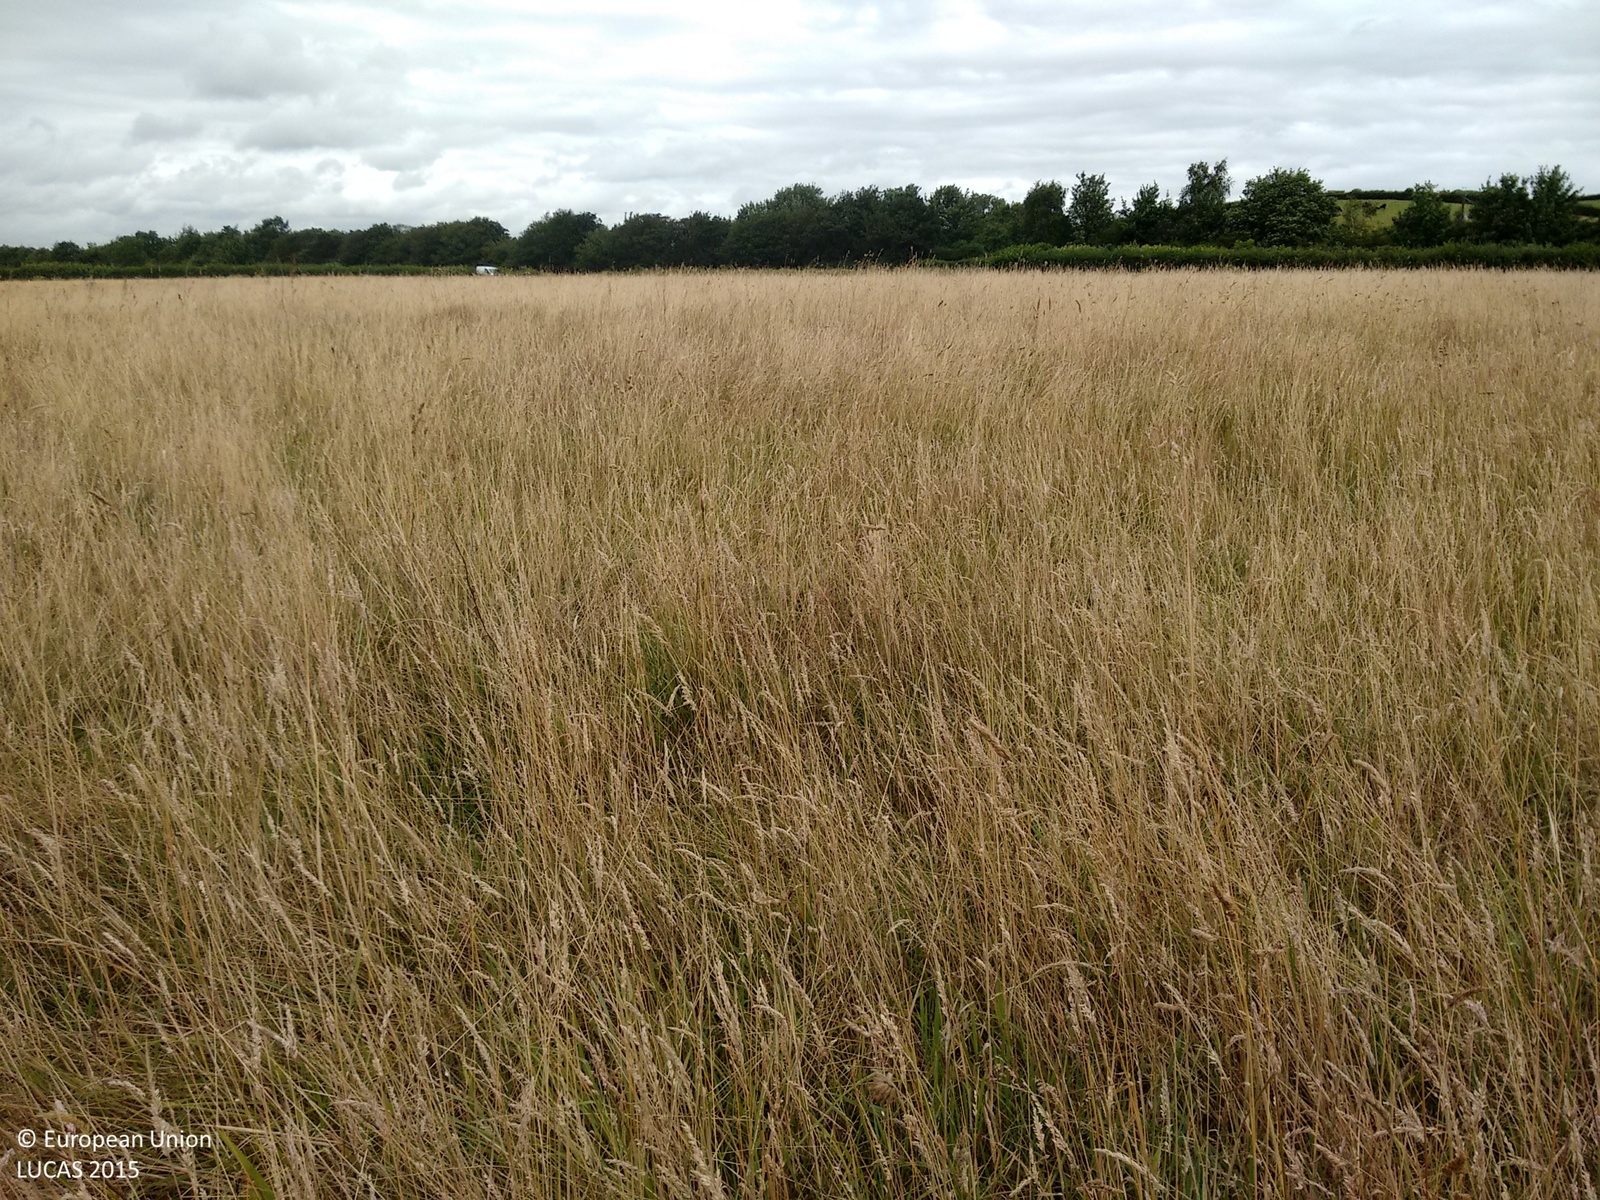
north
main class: Grassland
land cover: Grassland without tree/shrub cover
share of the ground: > 75 %
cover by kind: herbaceous plants 100 %
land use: Agriculture (excluding fallow land and kitchen gardens)
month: August
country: GB
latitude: 54.2388
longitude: -2.7267
